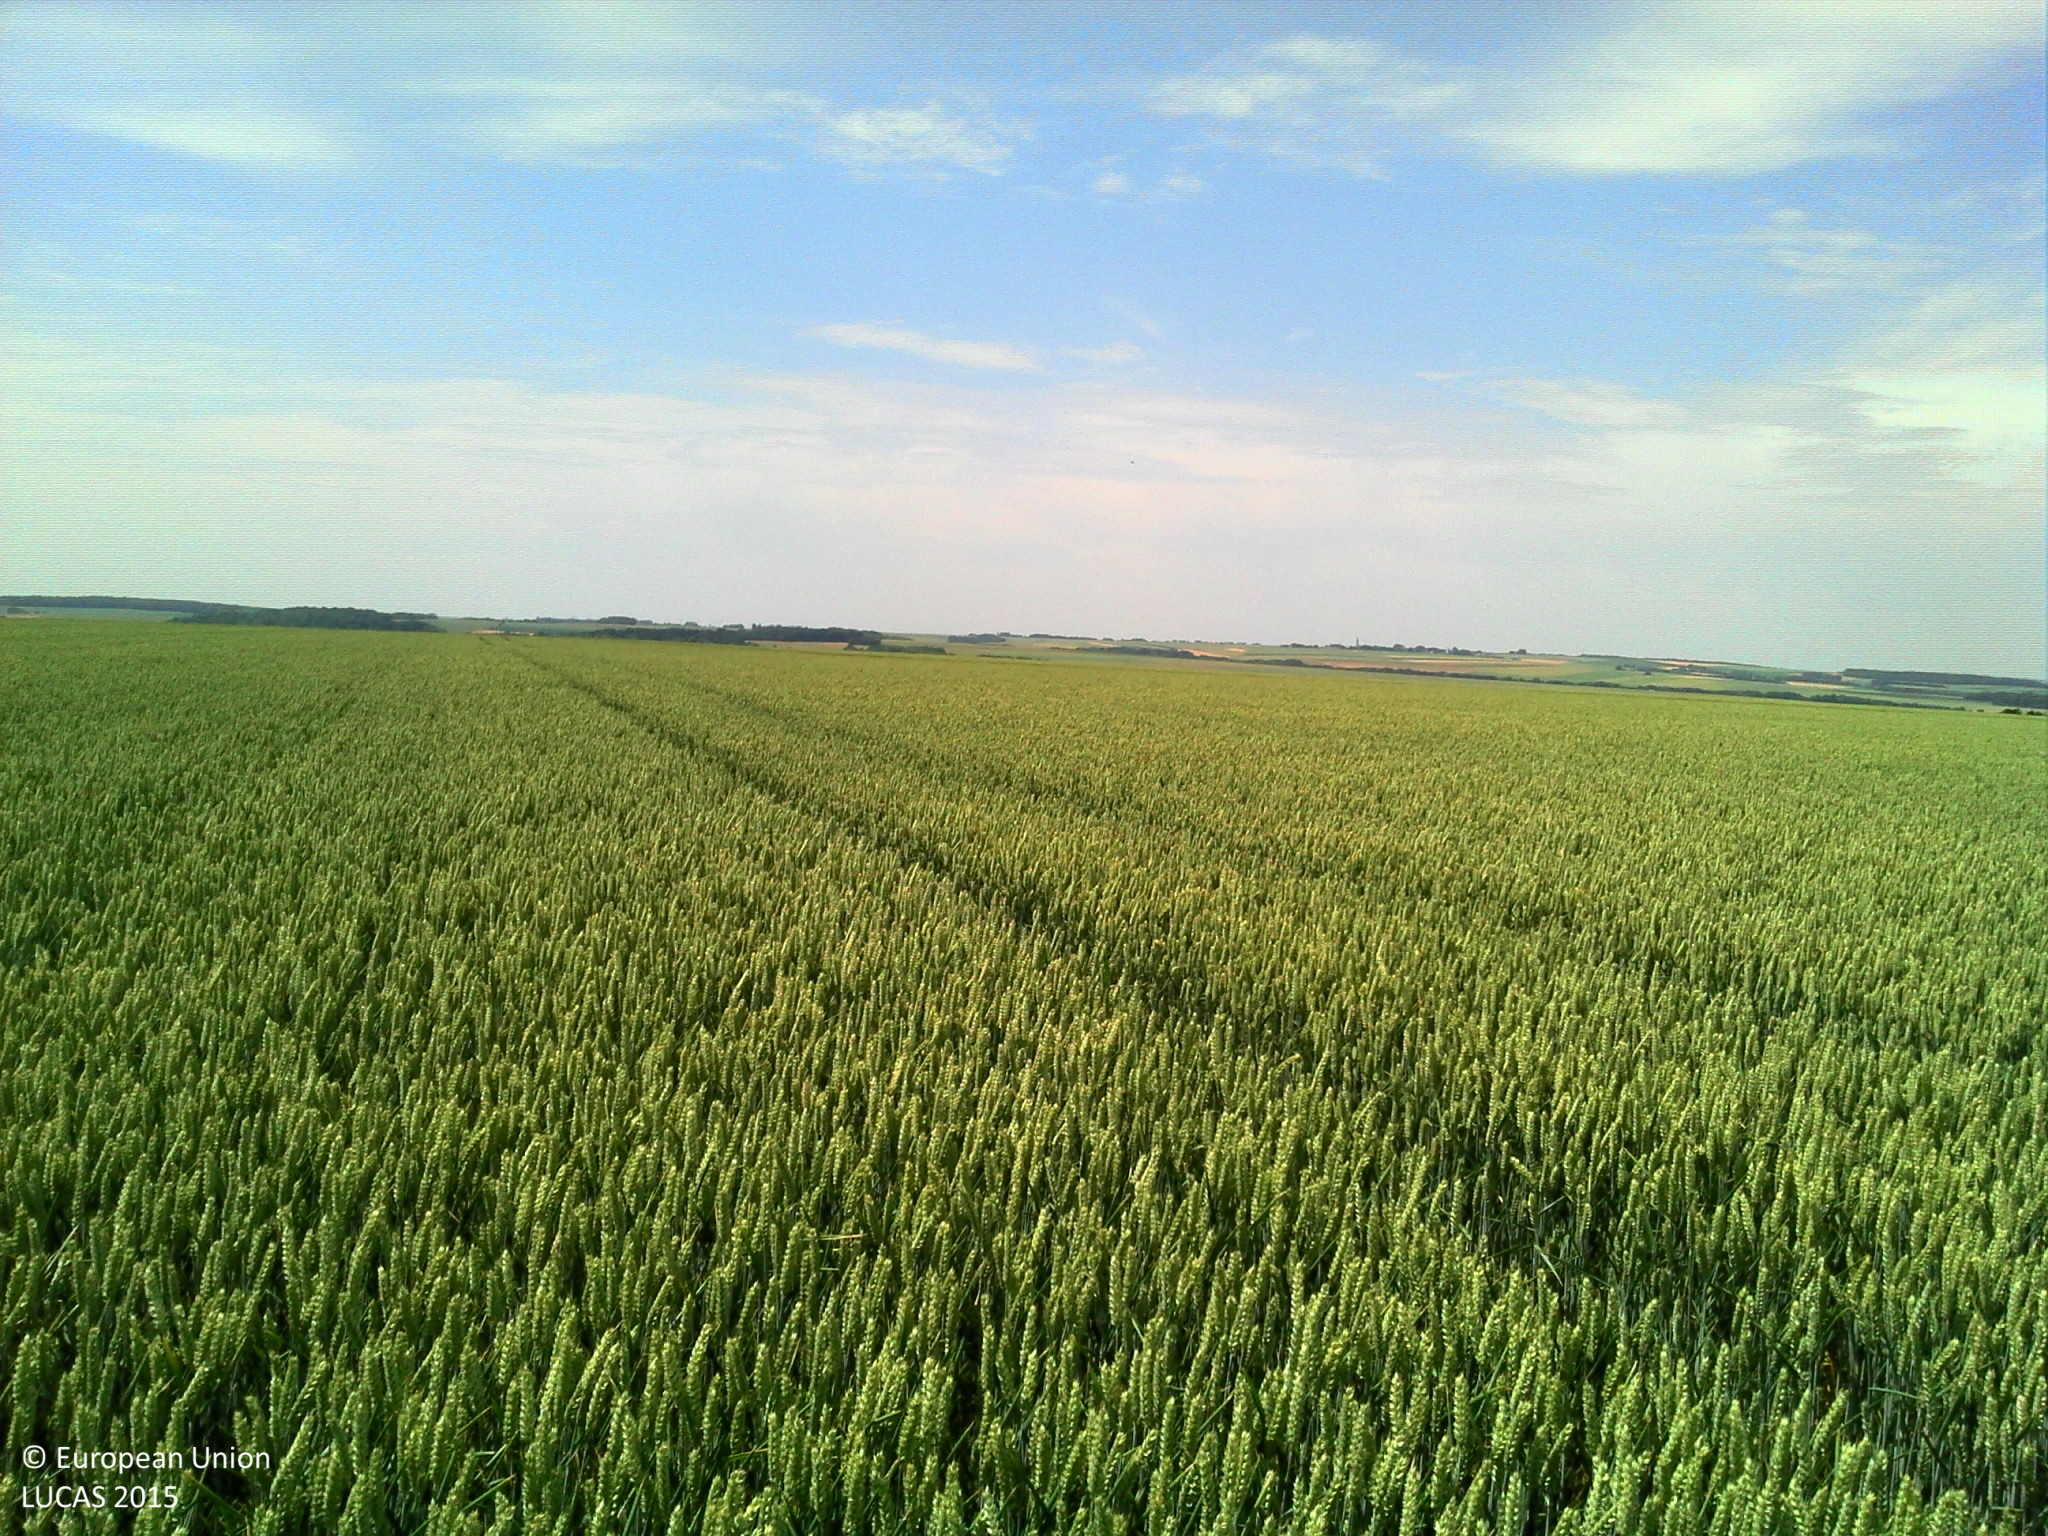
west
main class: Cropland
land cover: Common wheat
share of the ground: > 75 %
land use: Agriculture (excluding fallow land and kitchen gardens)
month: June
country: FR
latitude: 49.6827
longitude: 2.2108
